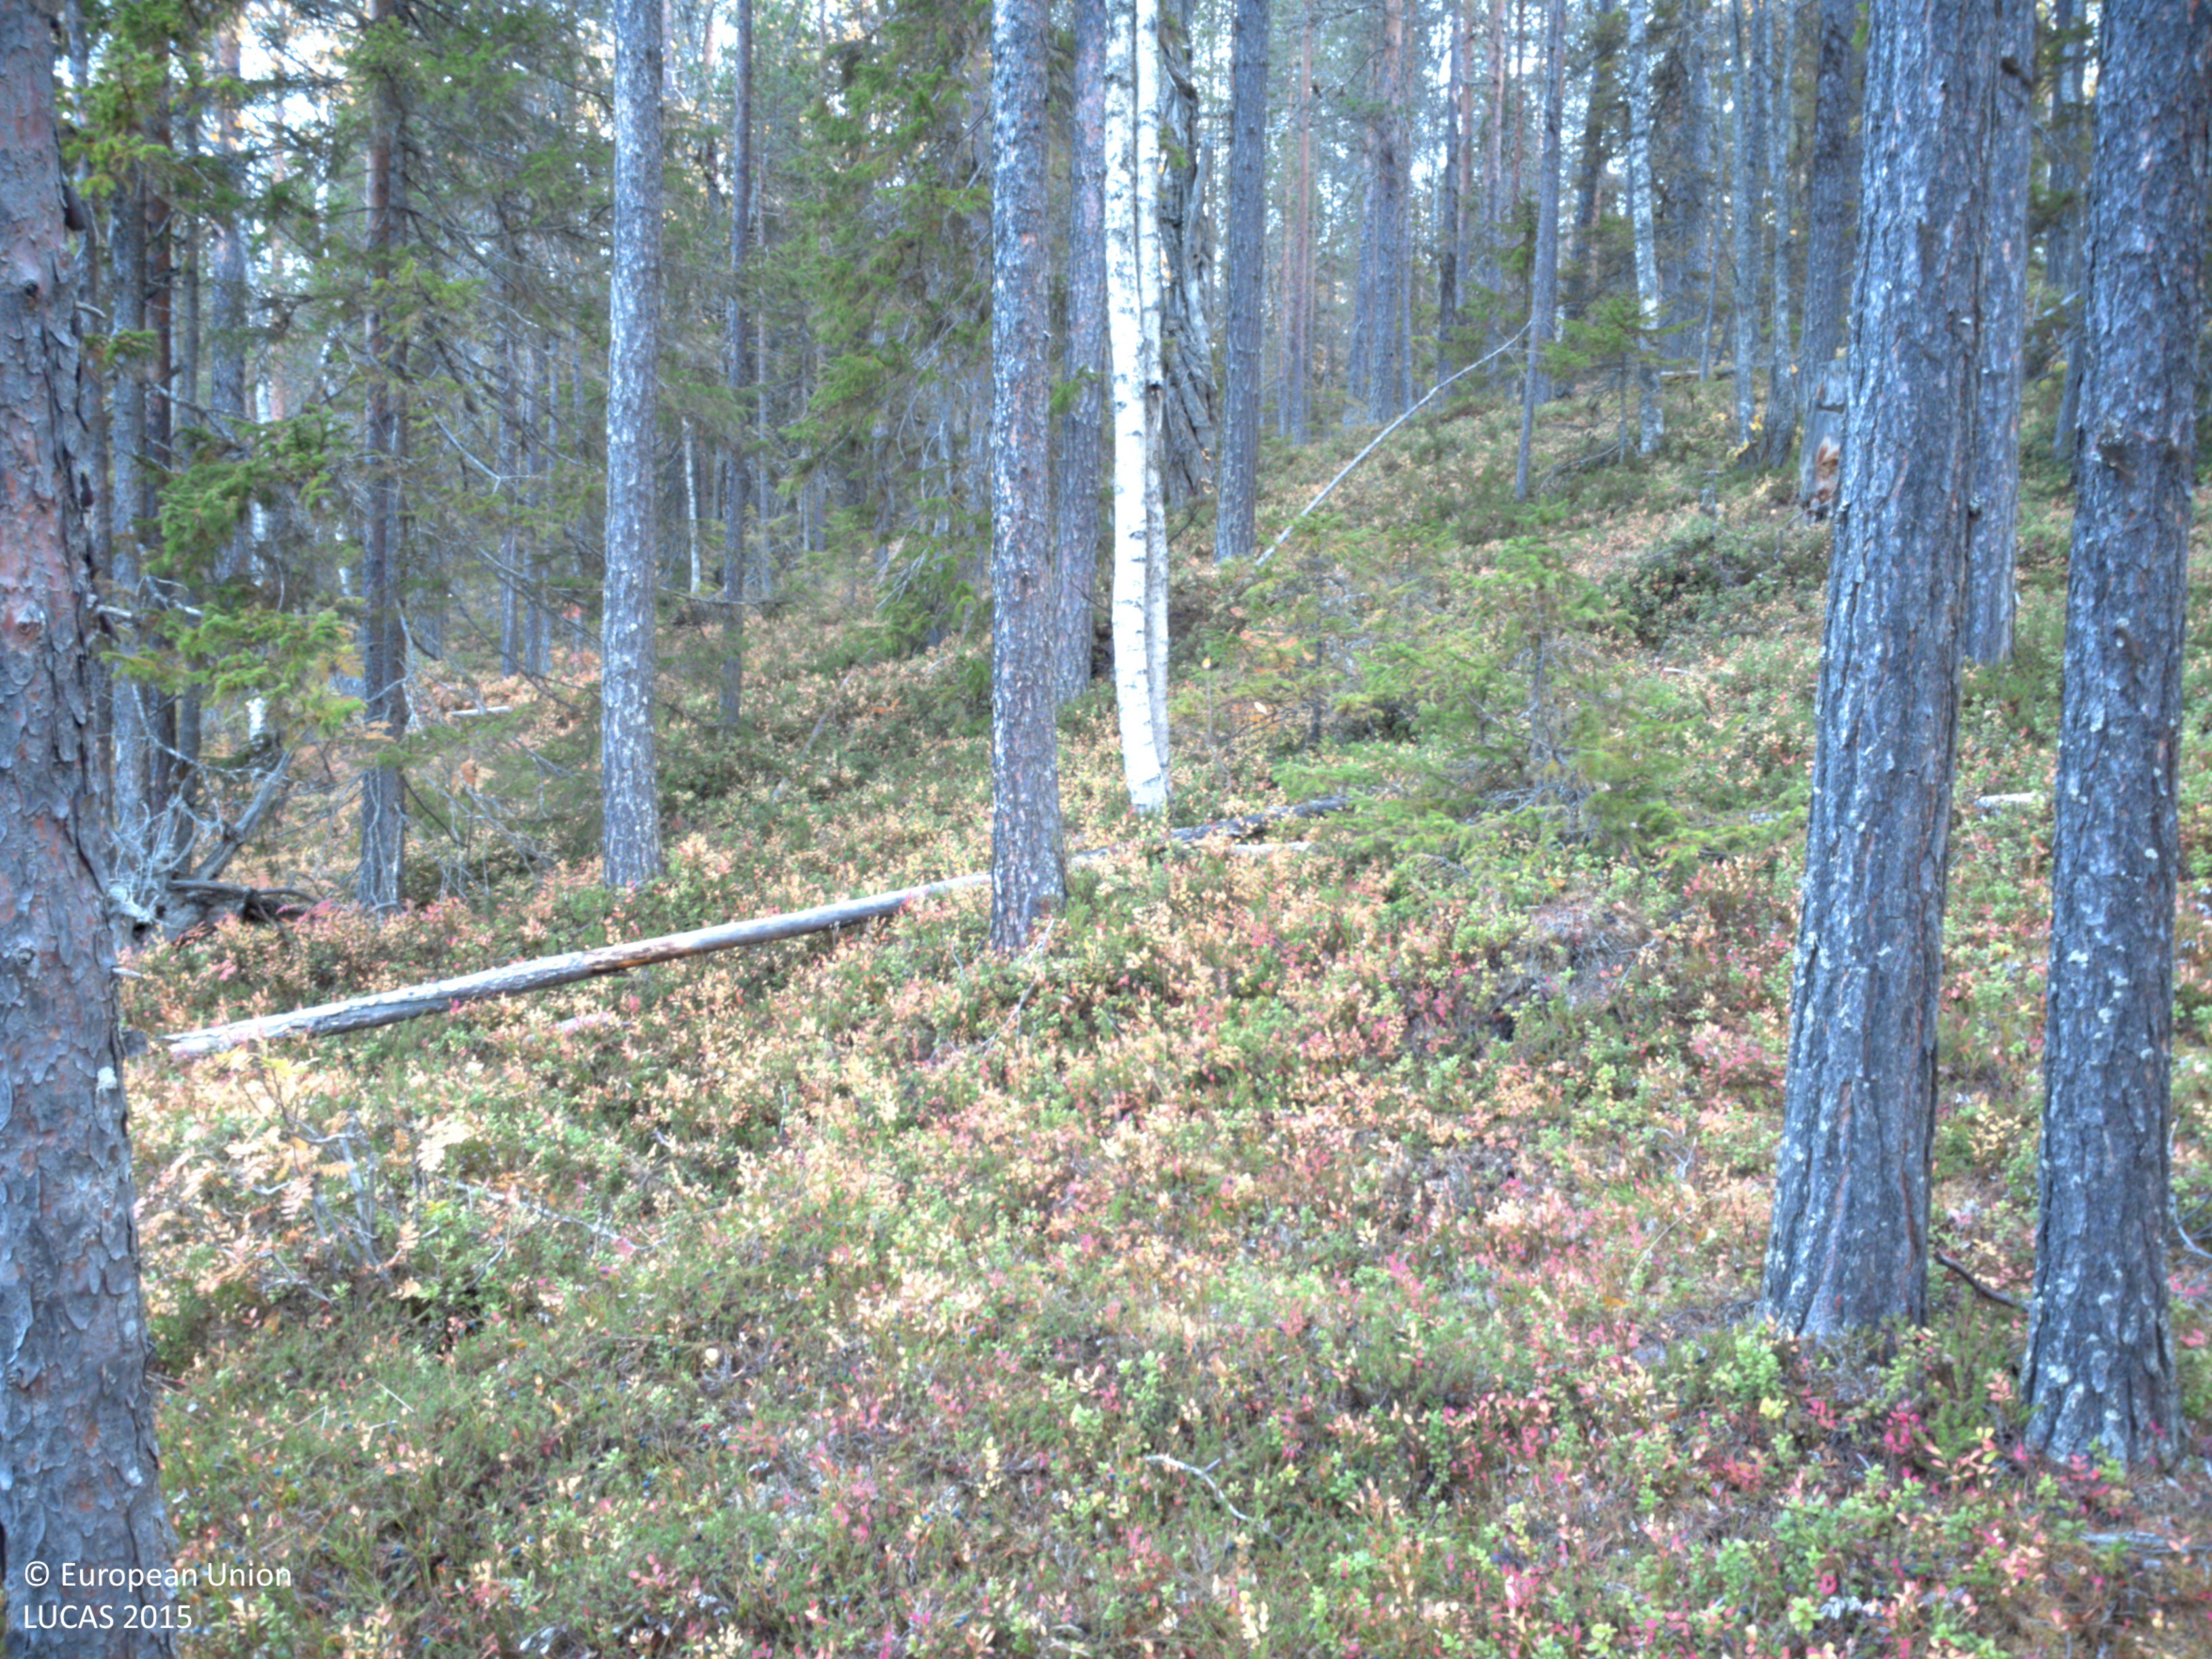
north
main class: Woodland
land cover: Pine dominated coniferous woodland
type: boreal forest
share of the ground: 50 - 75 %
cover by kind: coniferous forest trees 70 %, shrubs 20 %, herbaceous plants 5 %, lichens and mosses 5 %
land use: Forestry
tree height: > 5 m
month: October
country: SE
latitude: 64.6987
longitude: 18.1238
